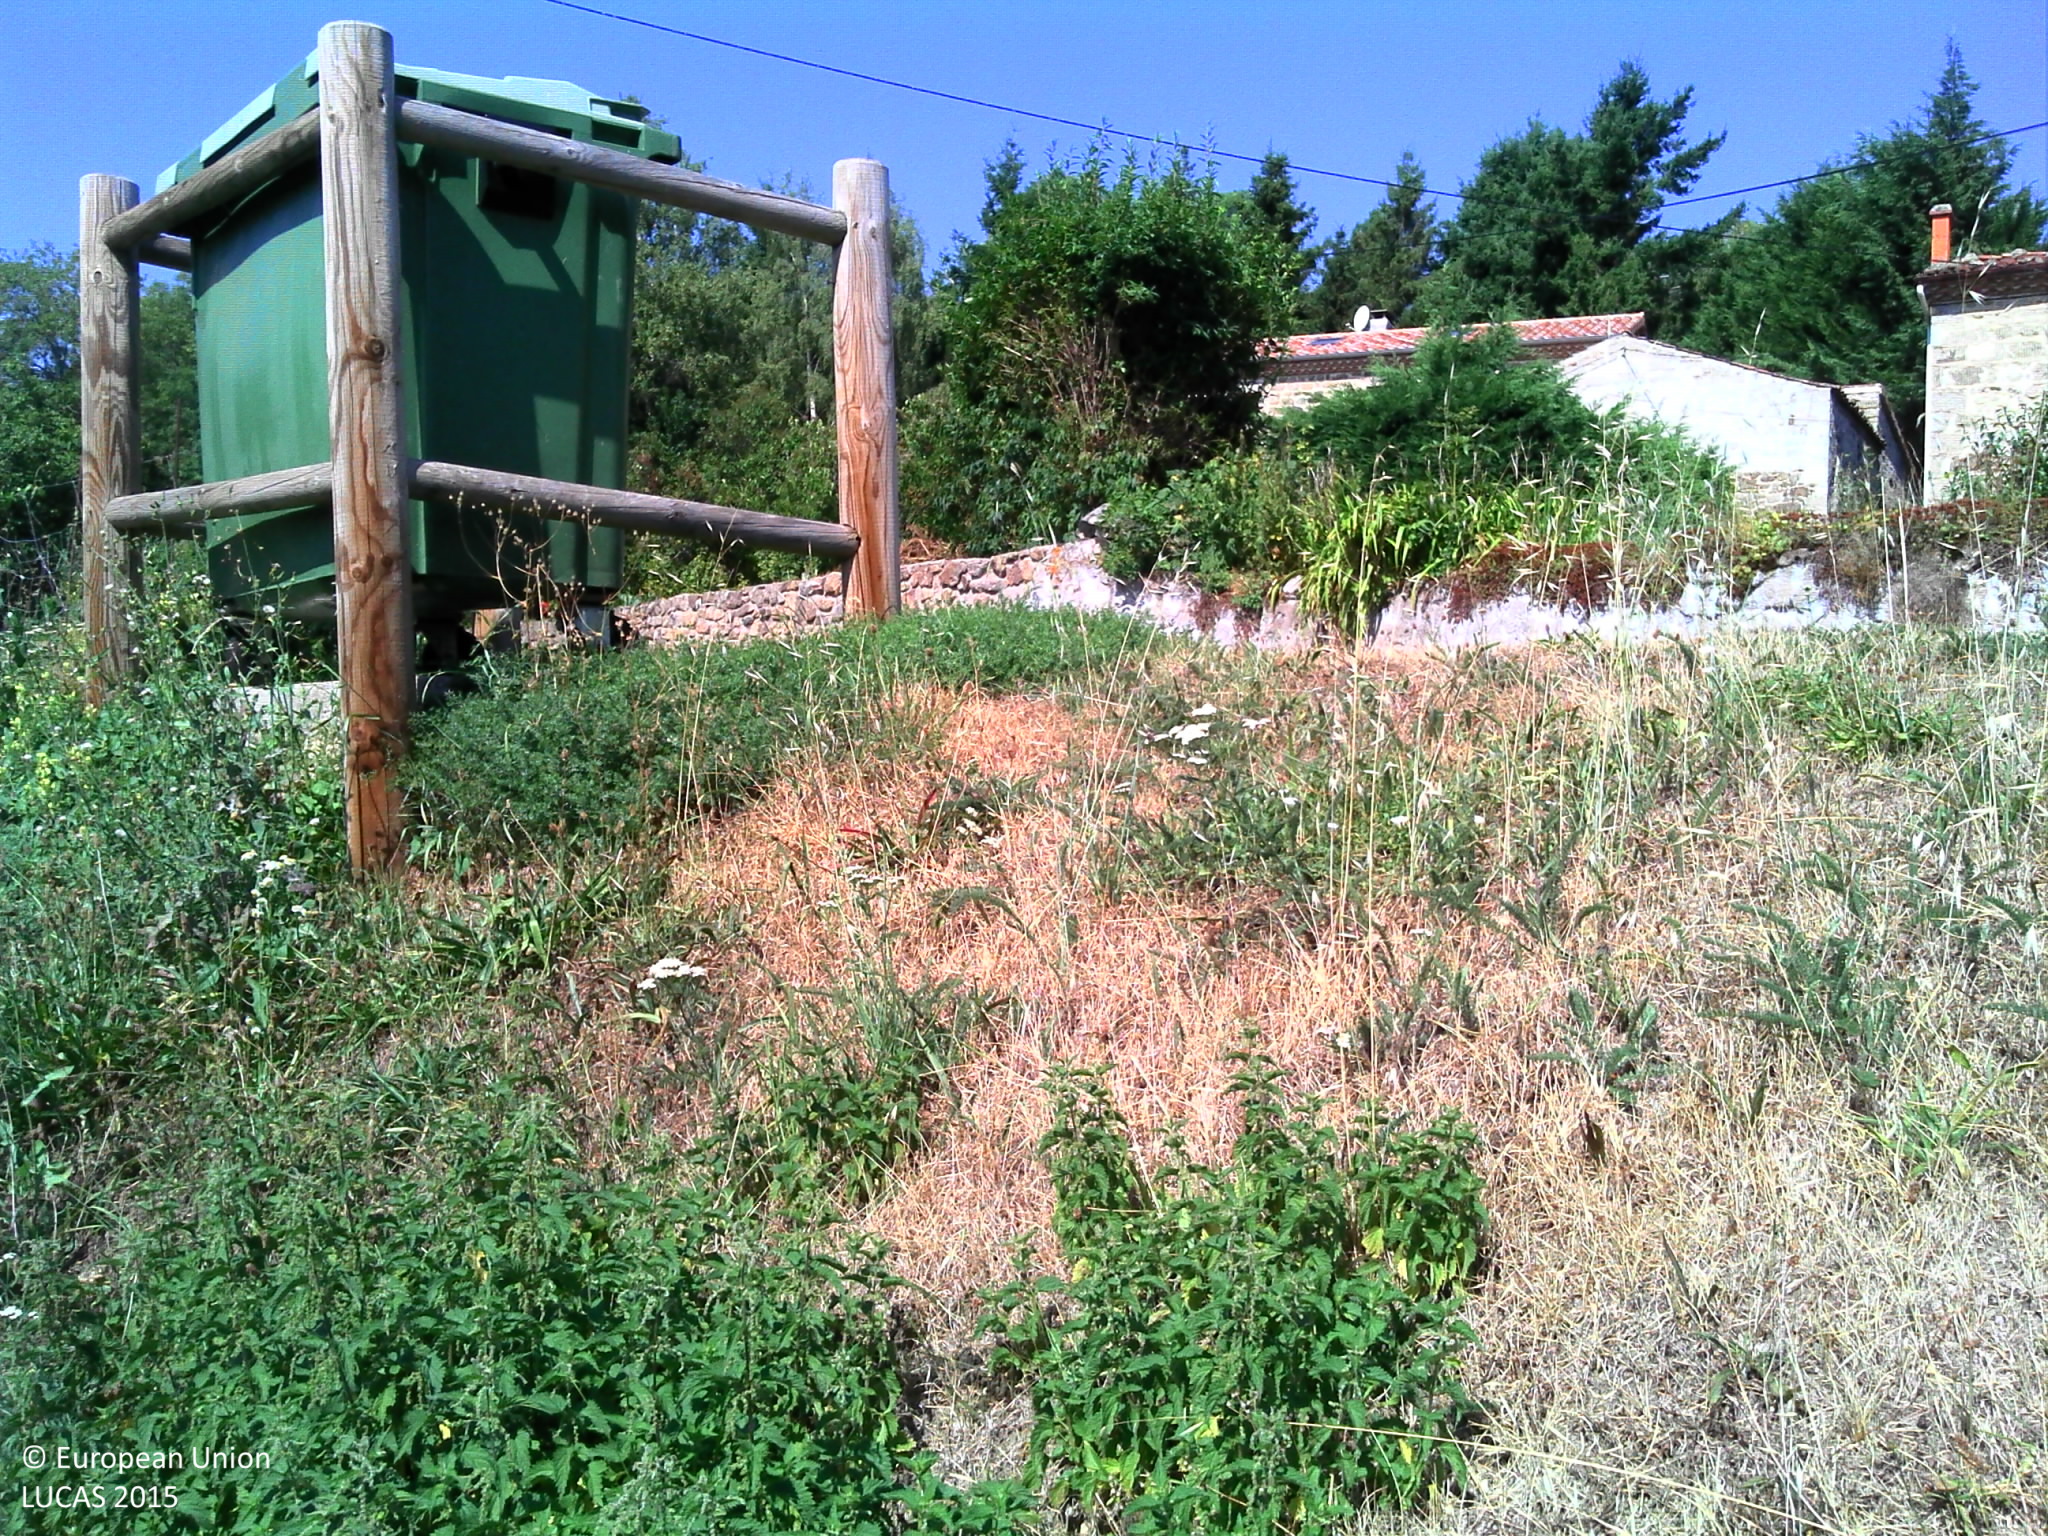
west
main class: Grassland
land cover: Grassland without tree/shrub cover
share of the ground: > 75 %
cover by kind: herbaceous plants 95 %, unconsolidated bare surface 5 %
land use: Semi-natural and natural areas not in use
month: August
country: FR
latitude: 45.3484
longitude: 4.6054
